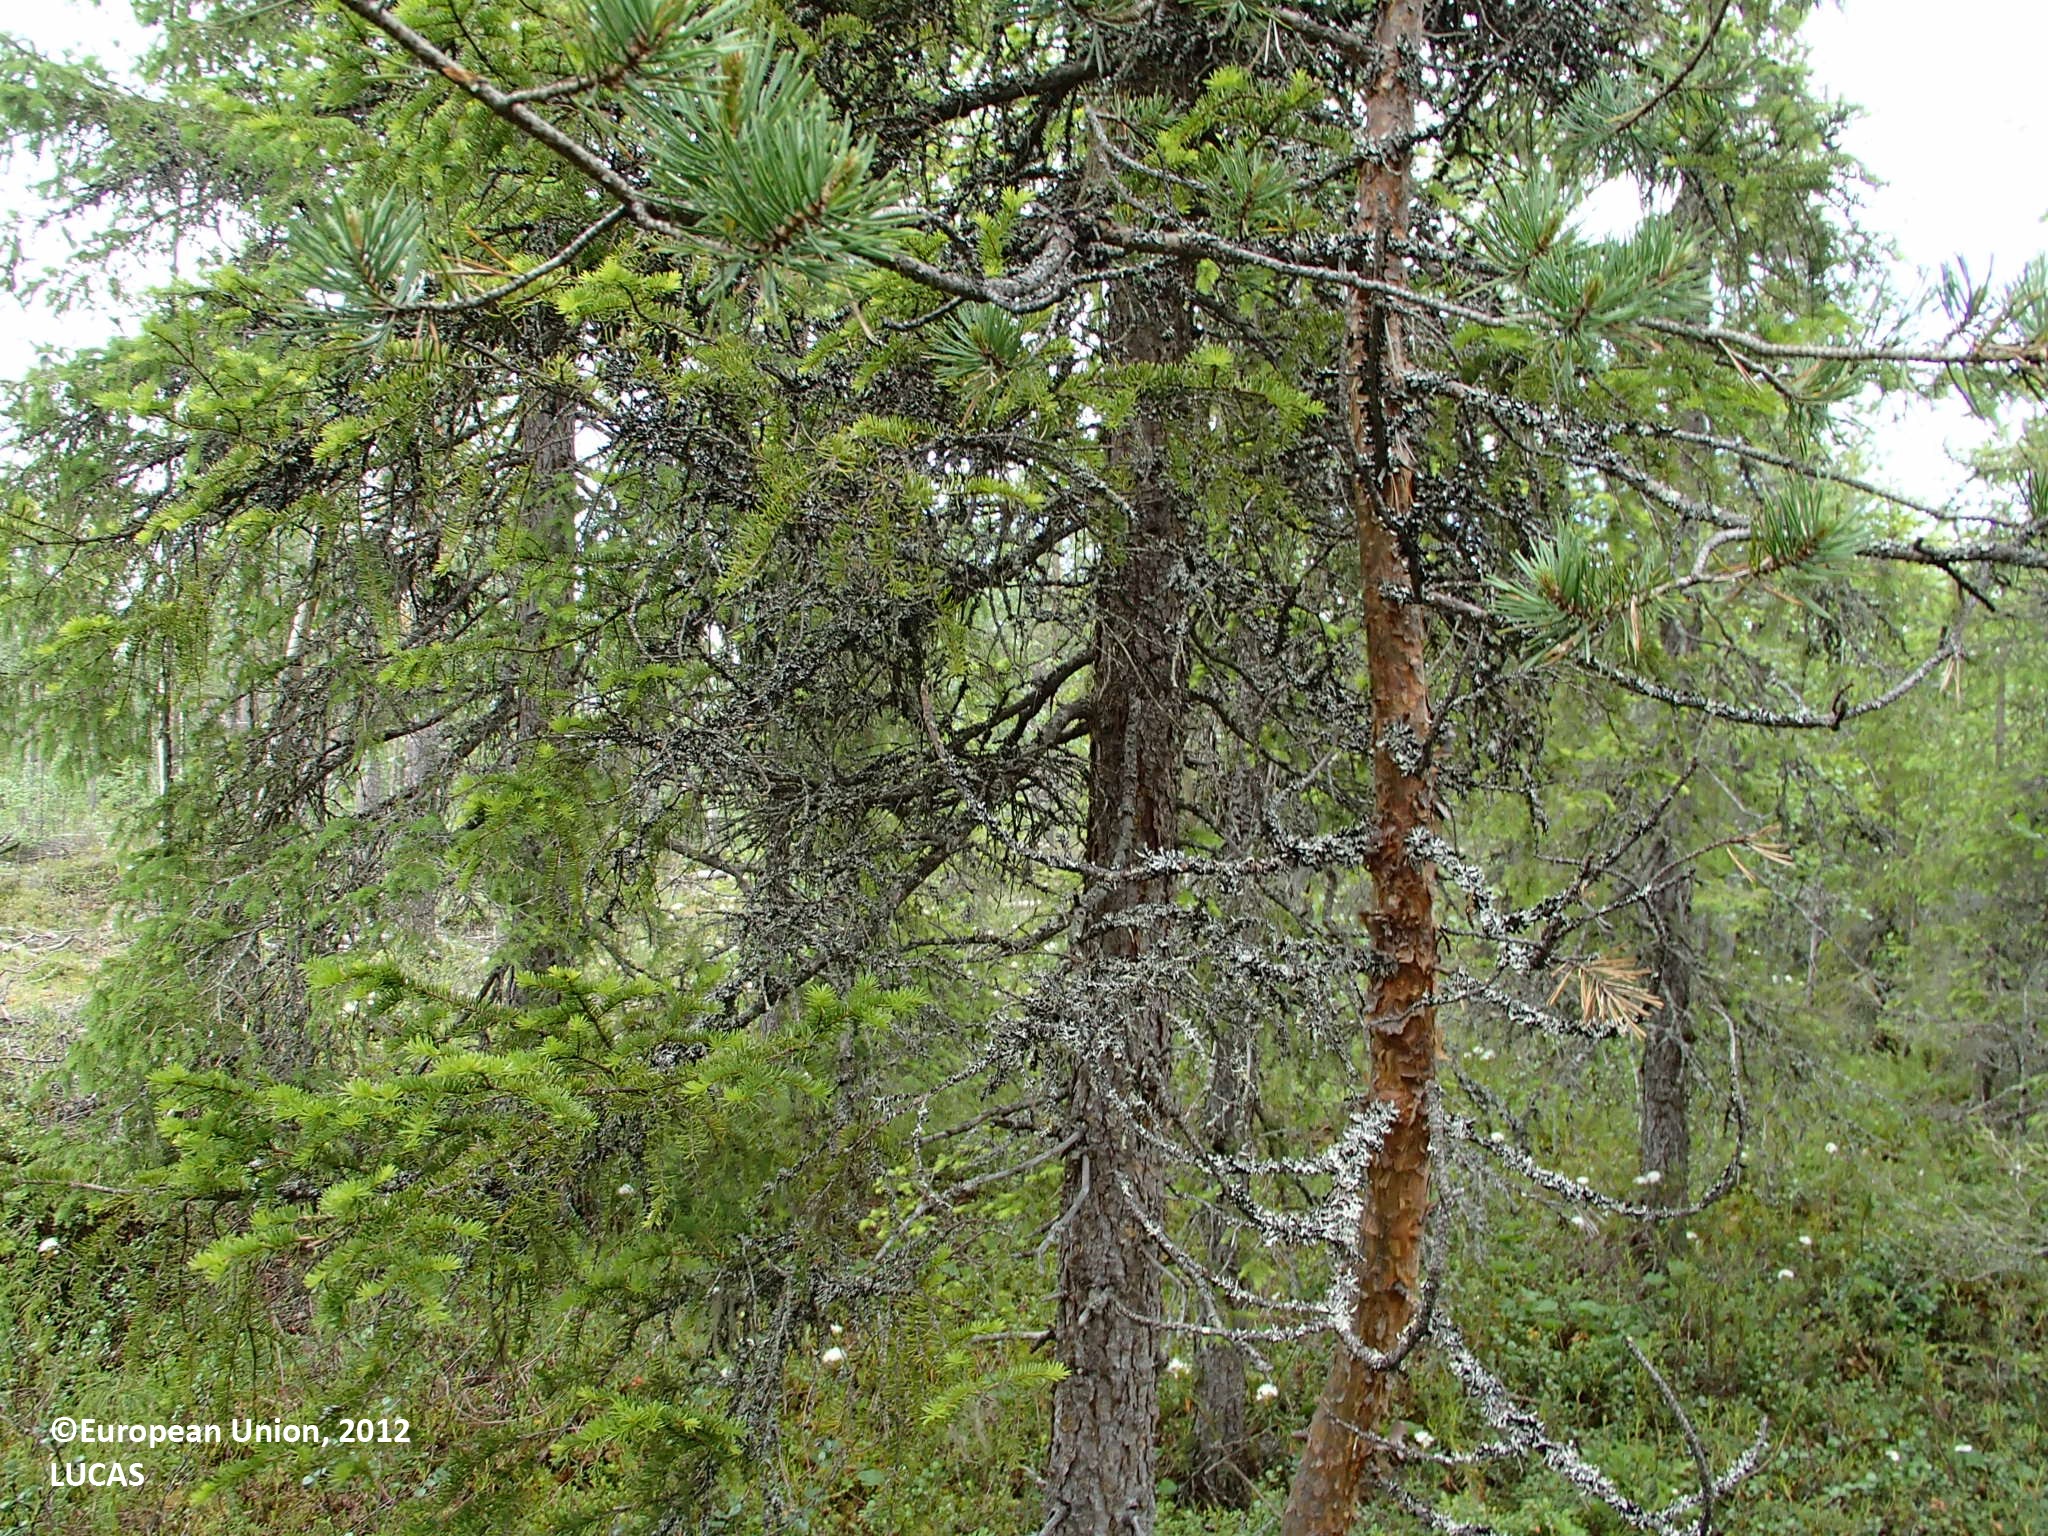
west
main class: Woodland
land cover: Spruce dominated coniferous woodland
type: boreal forest
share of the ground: > 75 %
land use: Forestry
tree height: > 5 m
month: July
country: FI
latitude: 66.9462
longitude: 27.9471
